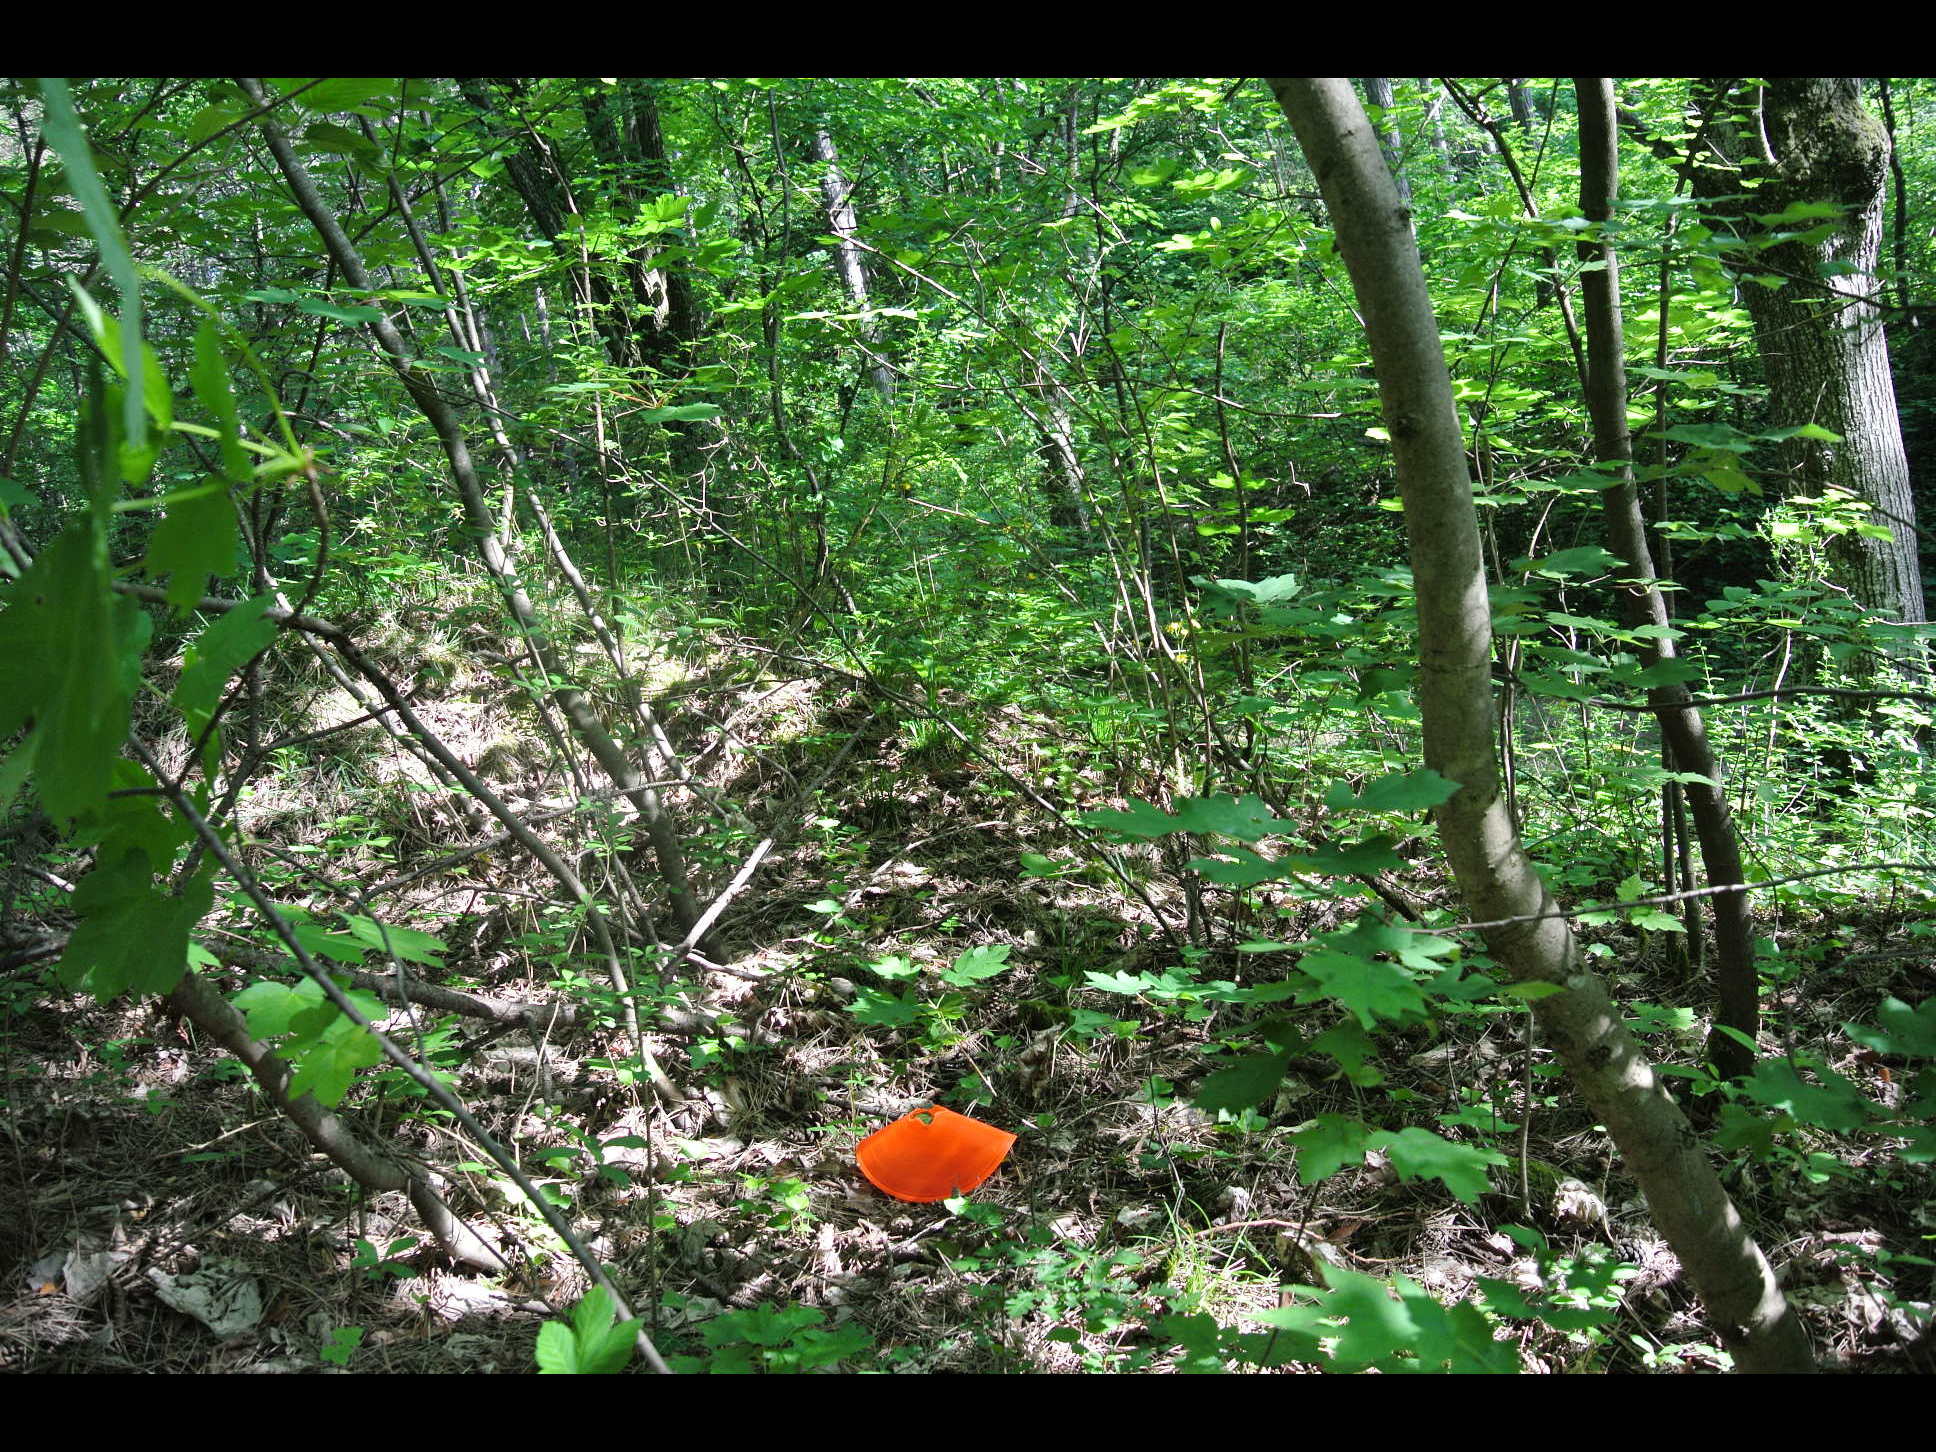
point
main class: Woodland
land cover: Pine dominated mixed woodland
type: alpine coniferous forest
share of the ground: > 75 %
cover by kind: broadleaved forest trees 75 %, coniferous forest trees 25 %
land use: Forestry
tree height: > 5 m
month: May
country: AT
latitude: 47.8346
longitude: 16.1625
